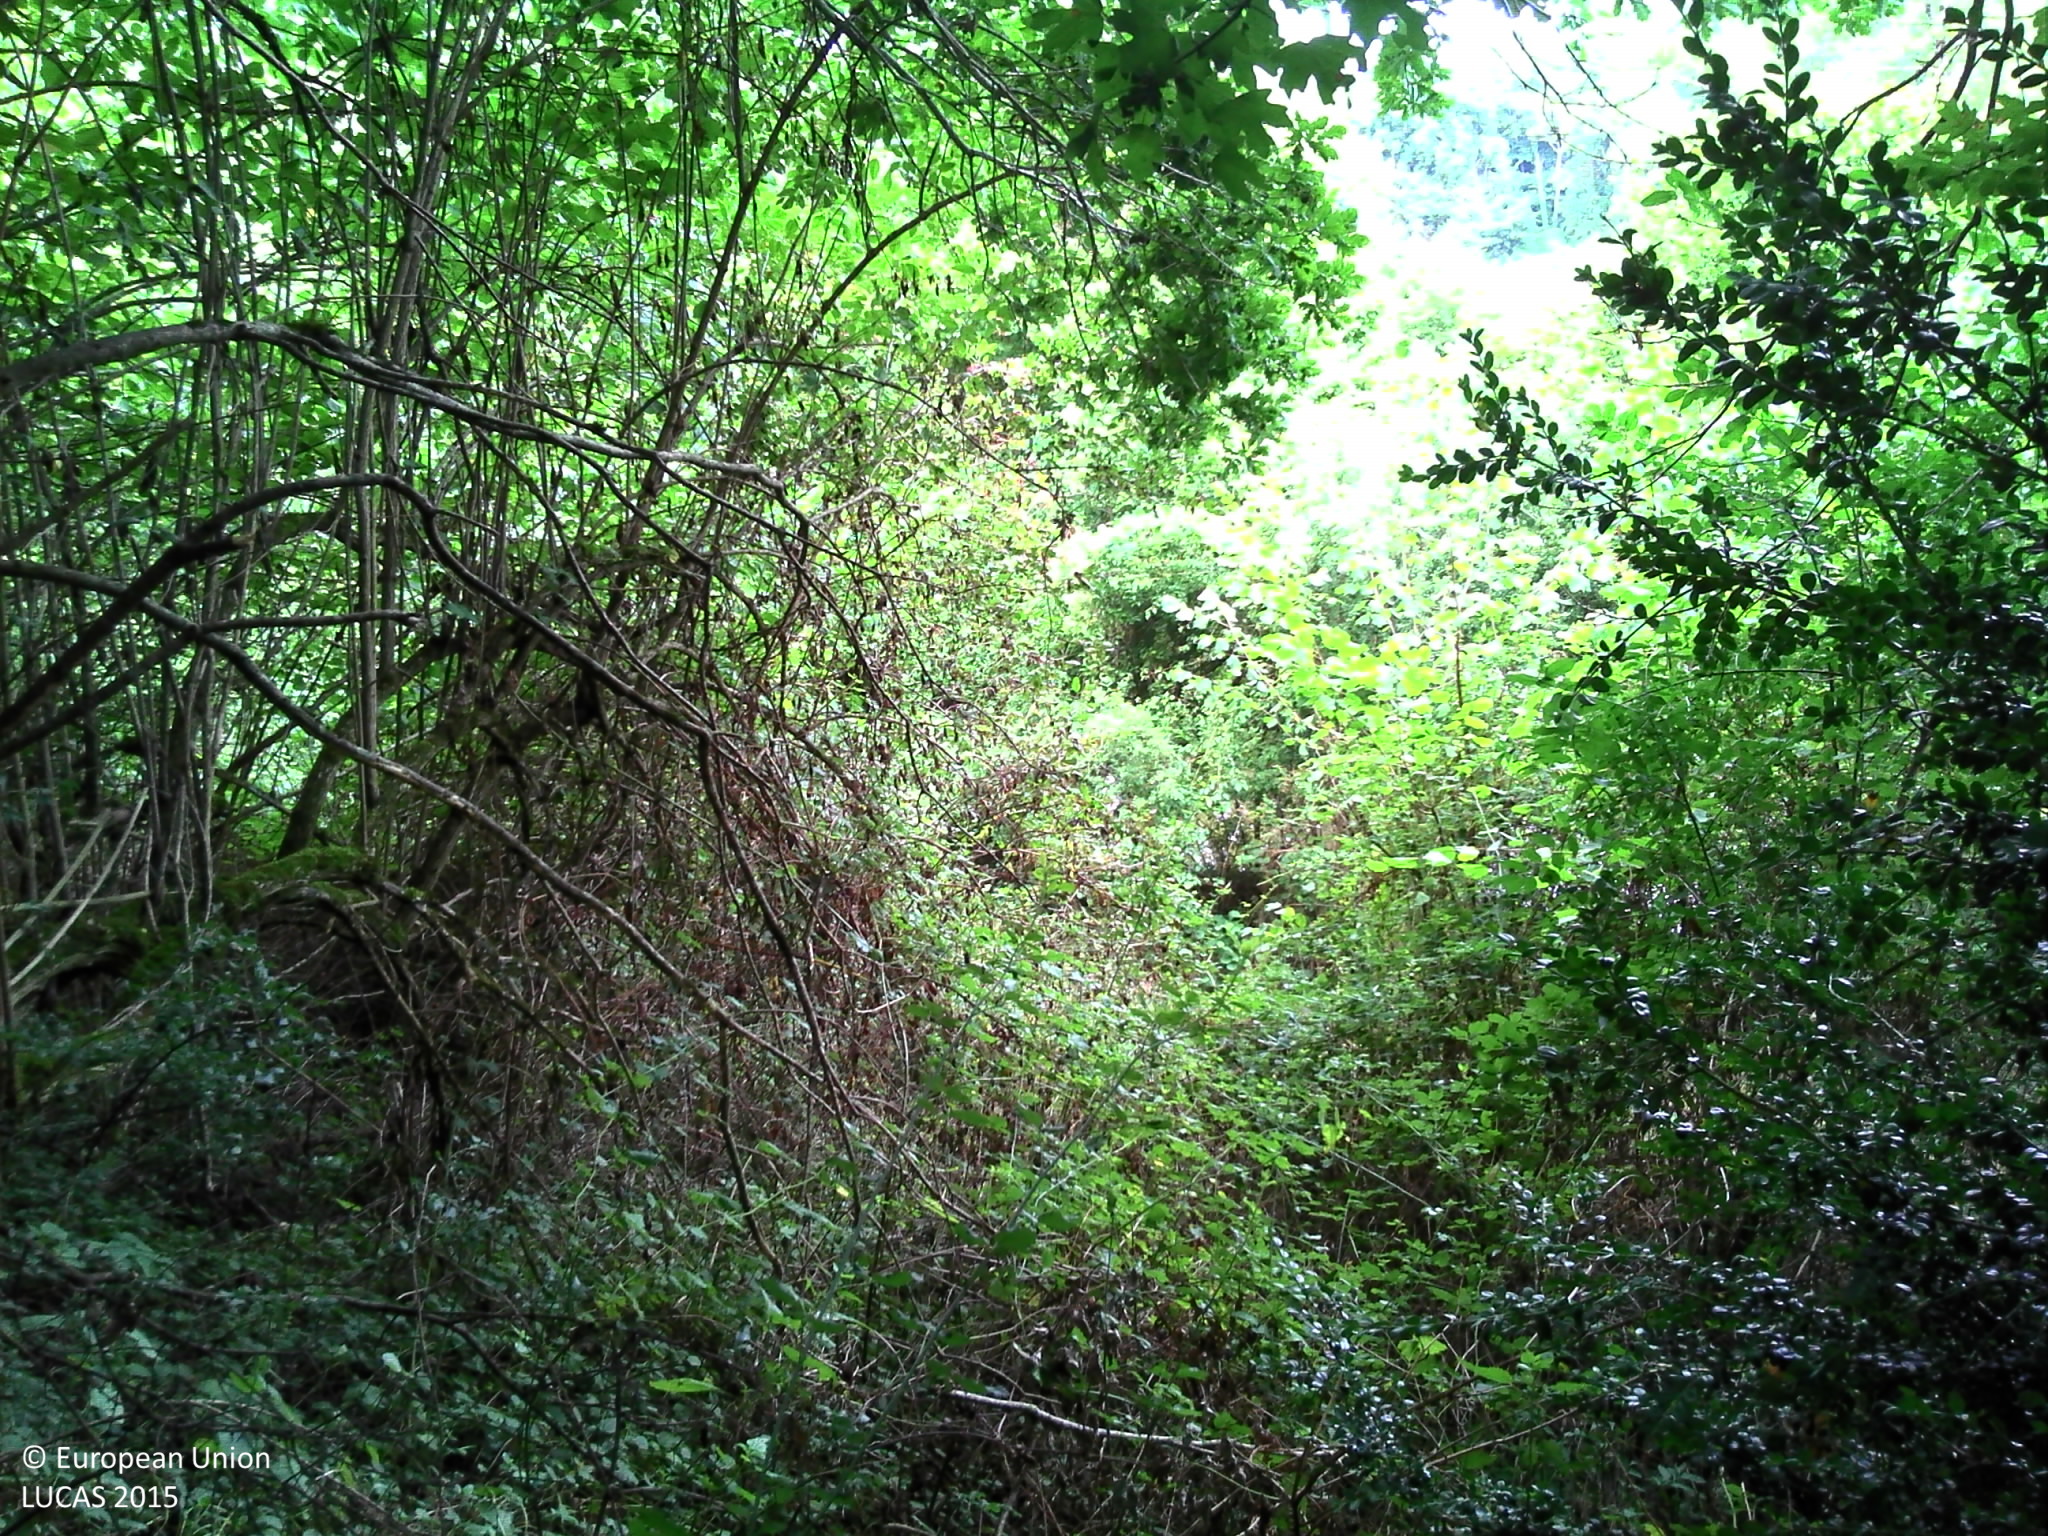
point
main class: Woodland
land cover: Broadleaved woodland
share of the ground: > 75 %
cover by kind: shrubs 60 %, broadleaved forest trees 20 %, herbaceous plants 20 %
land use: Semi-natural and natural areas not in use
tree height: < 5 m
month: August
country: FR
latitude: 46.1509
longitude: 0.3628
